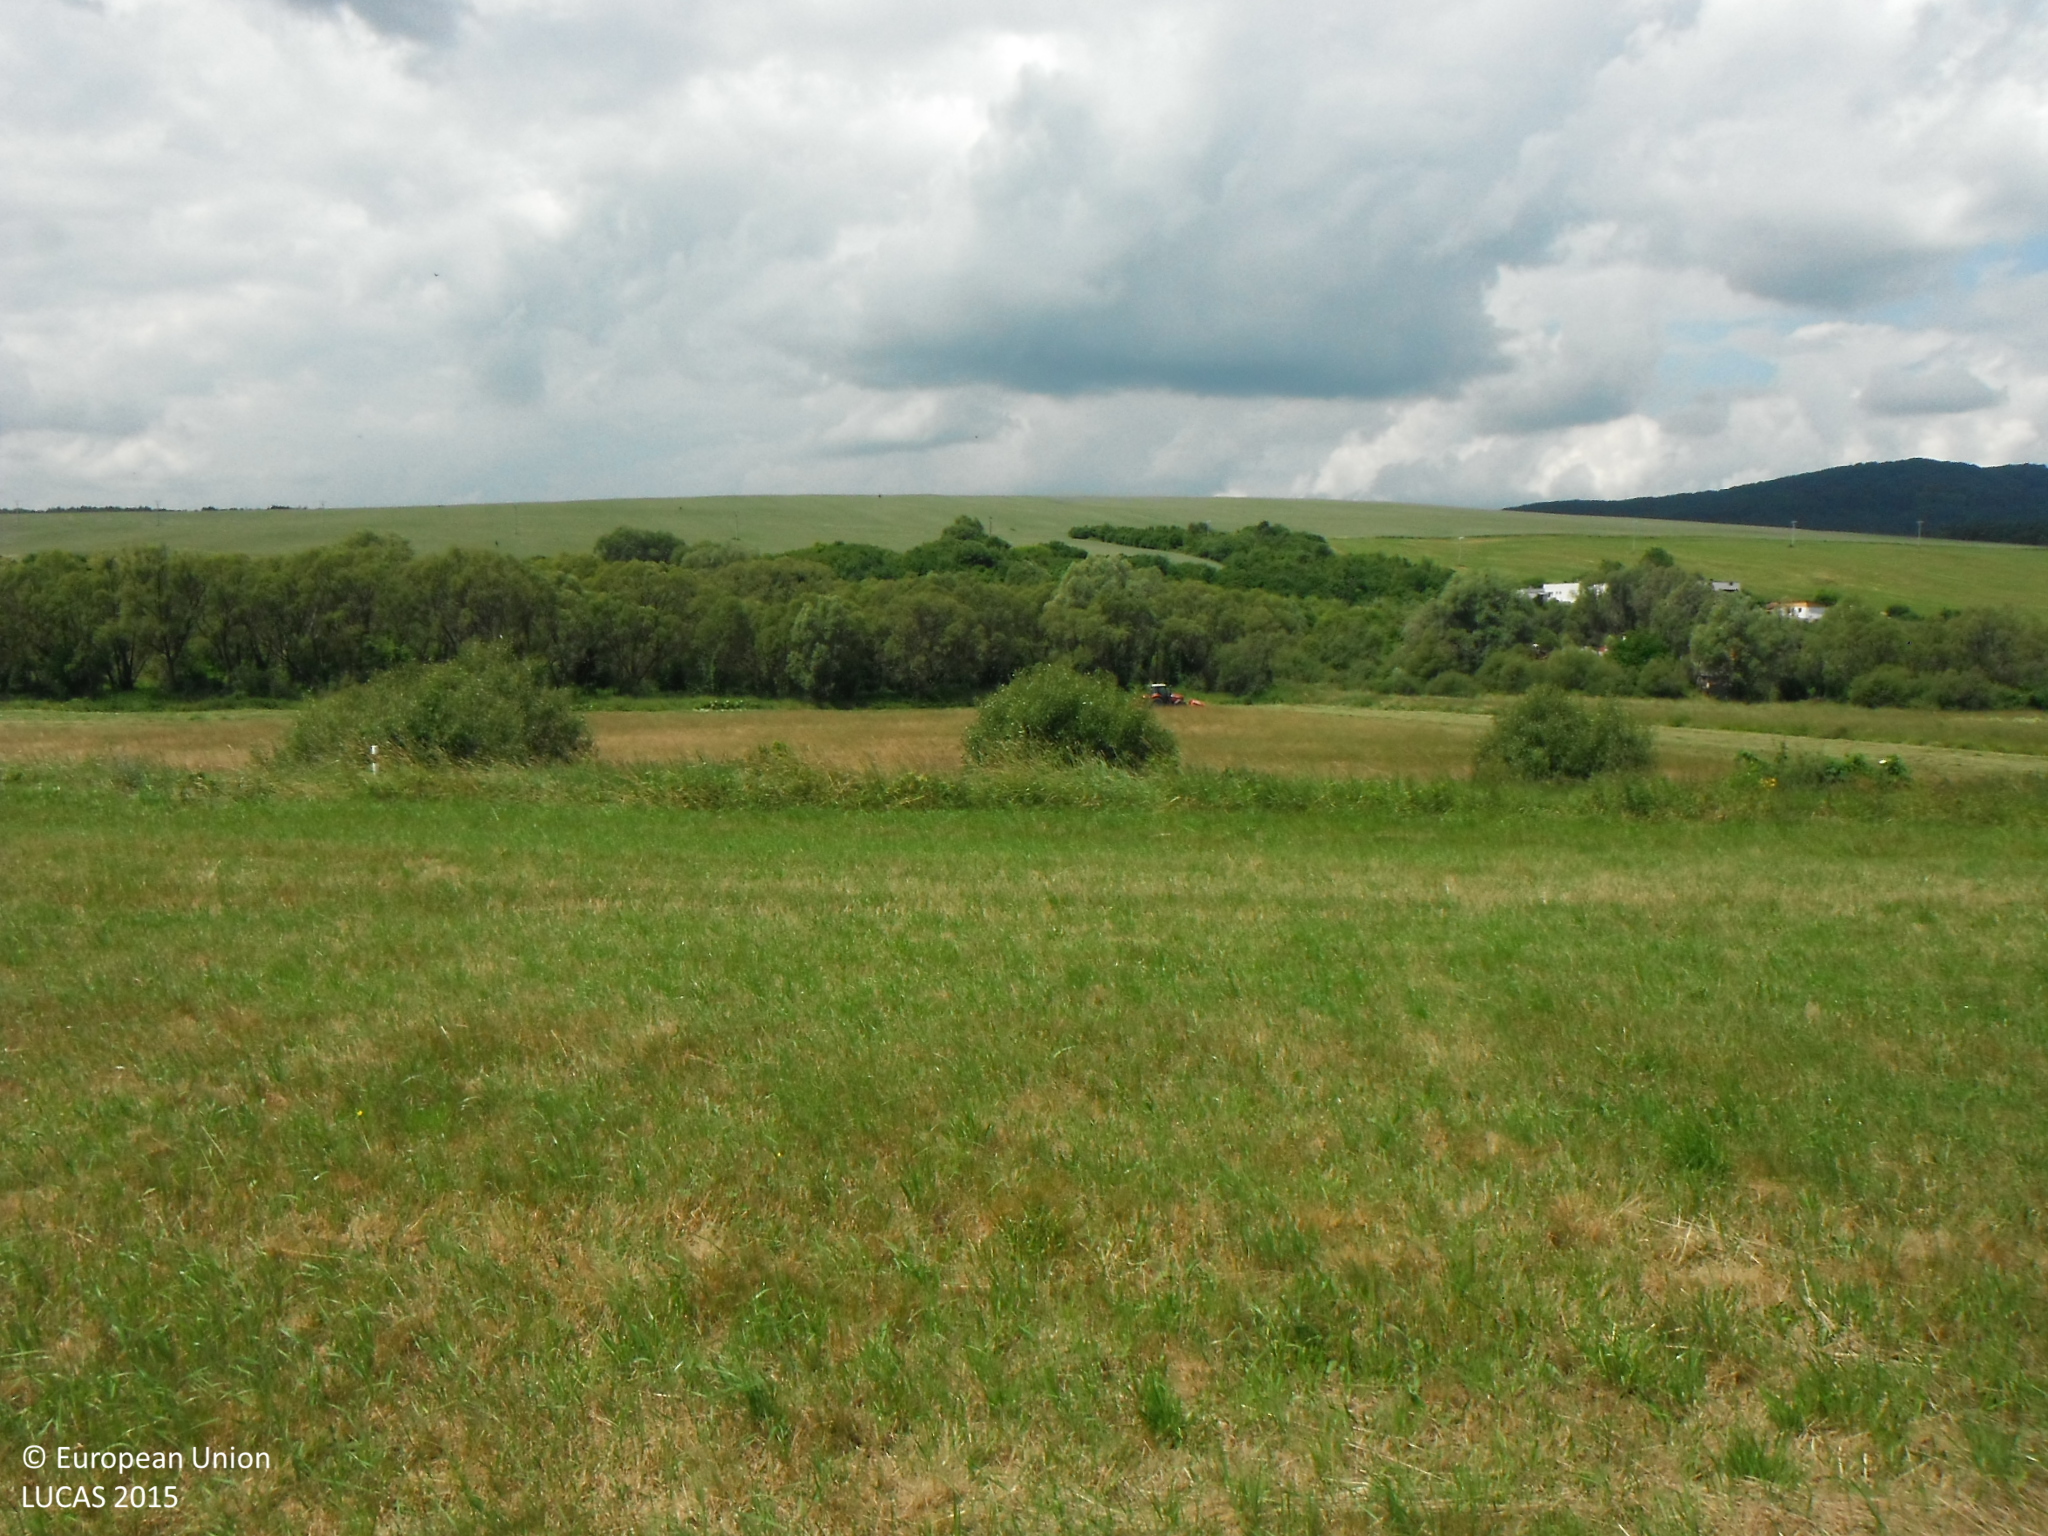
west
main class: Grassland
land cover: Grassland without tree/shrub cover
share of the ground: > 75 %
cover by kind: herbaceous plants 100 %
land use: Agriculture (excluding fallow land and kitchen gardens)
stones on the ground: < 10 %
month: June
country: SK
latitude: 49.3358
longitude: 21.5967
